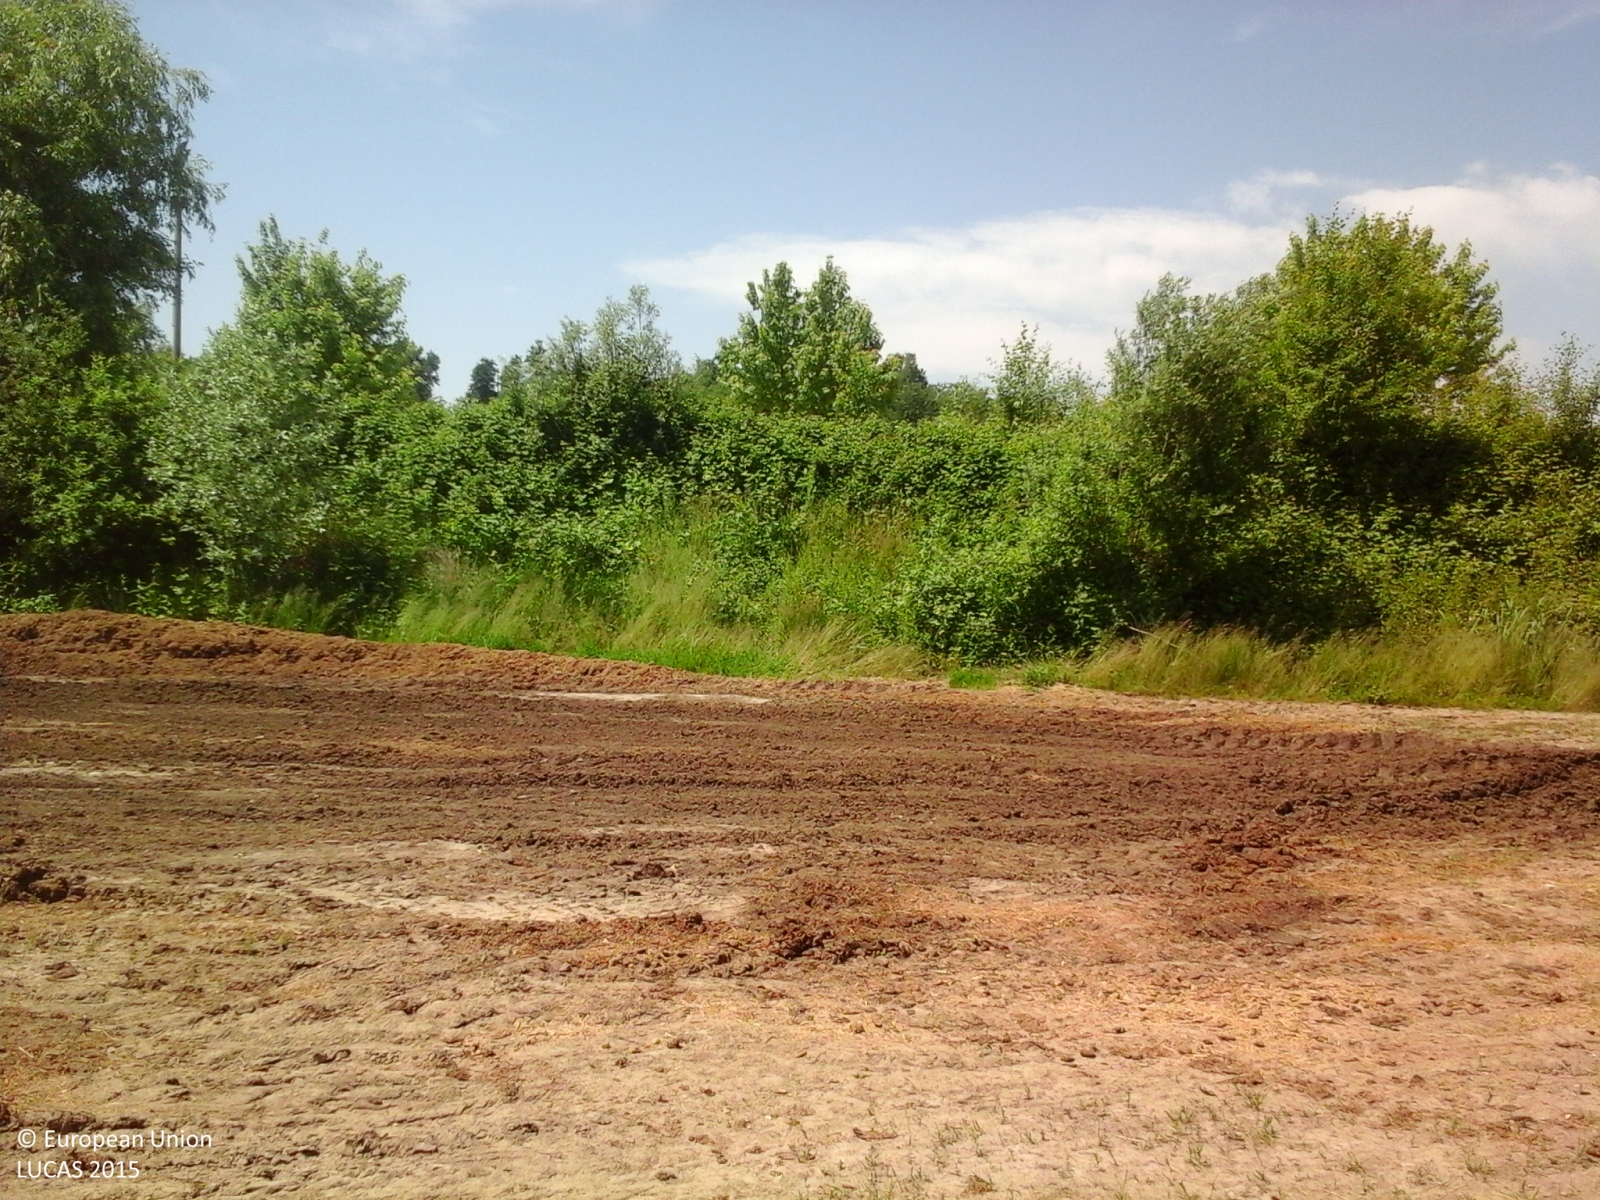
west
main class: Grassland
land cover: Grassland without tree/shrub cover
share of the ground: > 75 %
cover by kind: herbaceous plants 100 %
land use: Agriculture (excluding fallow land and kitchen gardens)
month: May
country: IT
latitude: 45.5316
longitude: 8.6321
